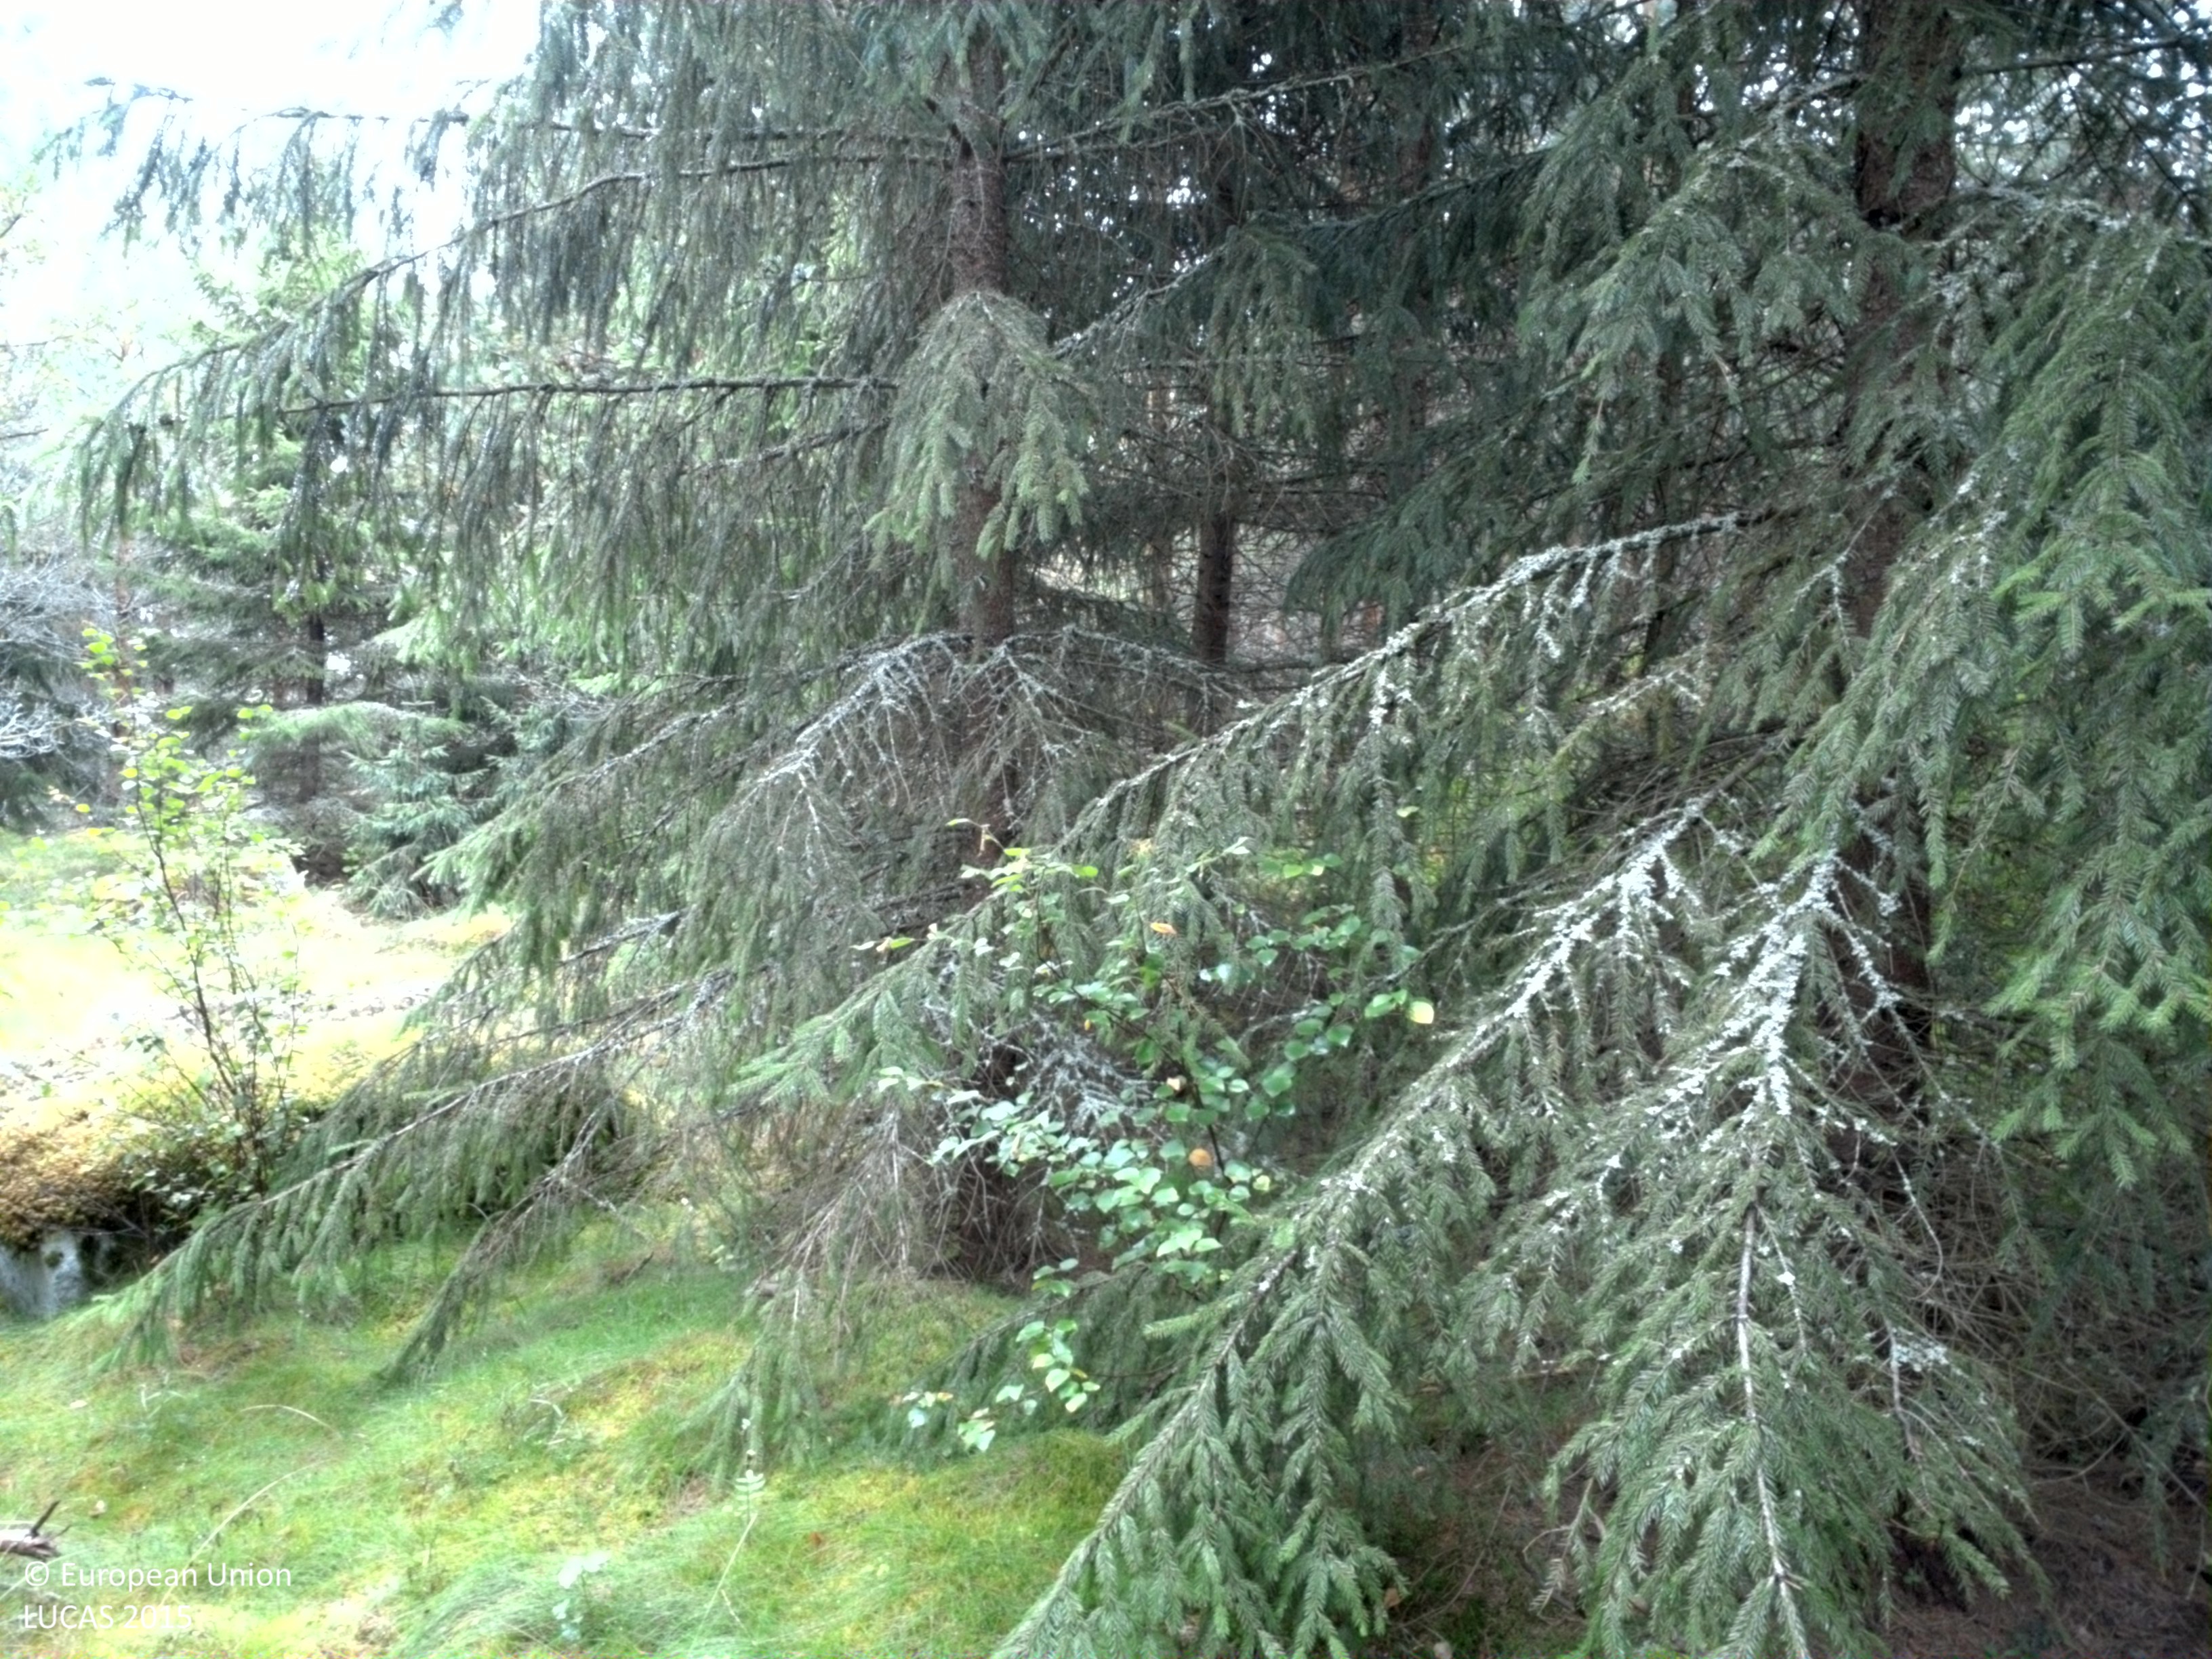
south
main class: Woodland
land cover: Pine dominated coniferous woodland
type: boreal forest
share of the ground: 50 - 75 %
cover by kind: coniferous forest trees 65 %, herbaceous plants 25 %, broadleaved forest trees 10 %
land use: Forestry
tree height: > 5 m
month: August
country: SE
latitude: 59.9355
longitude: 17.6713
